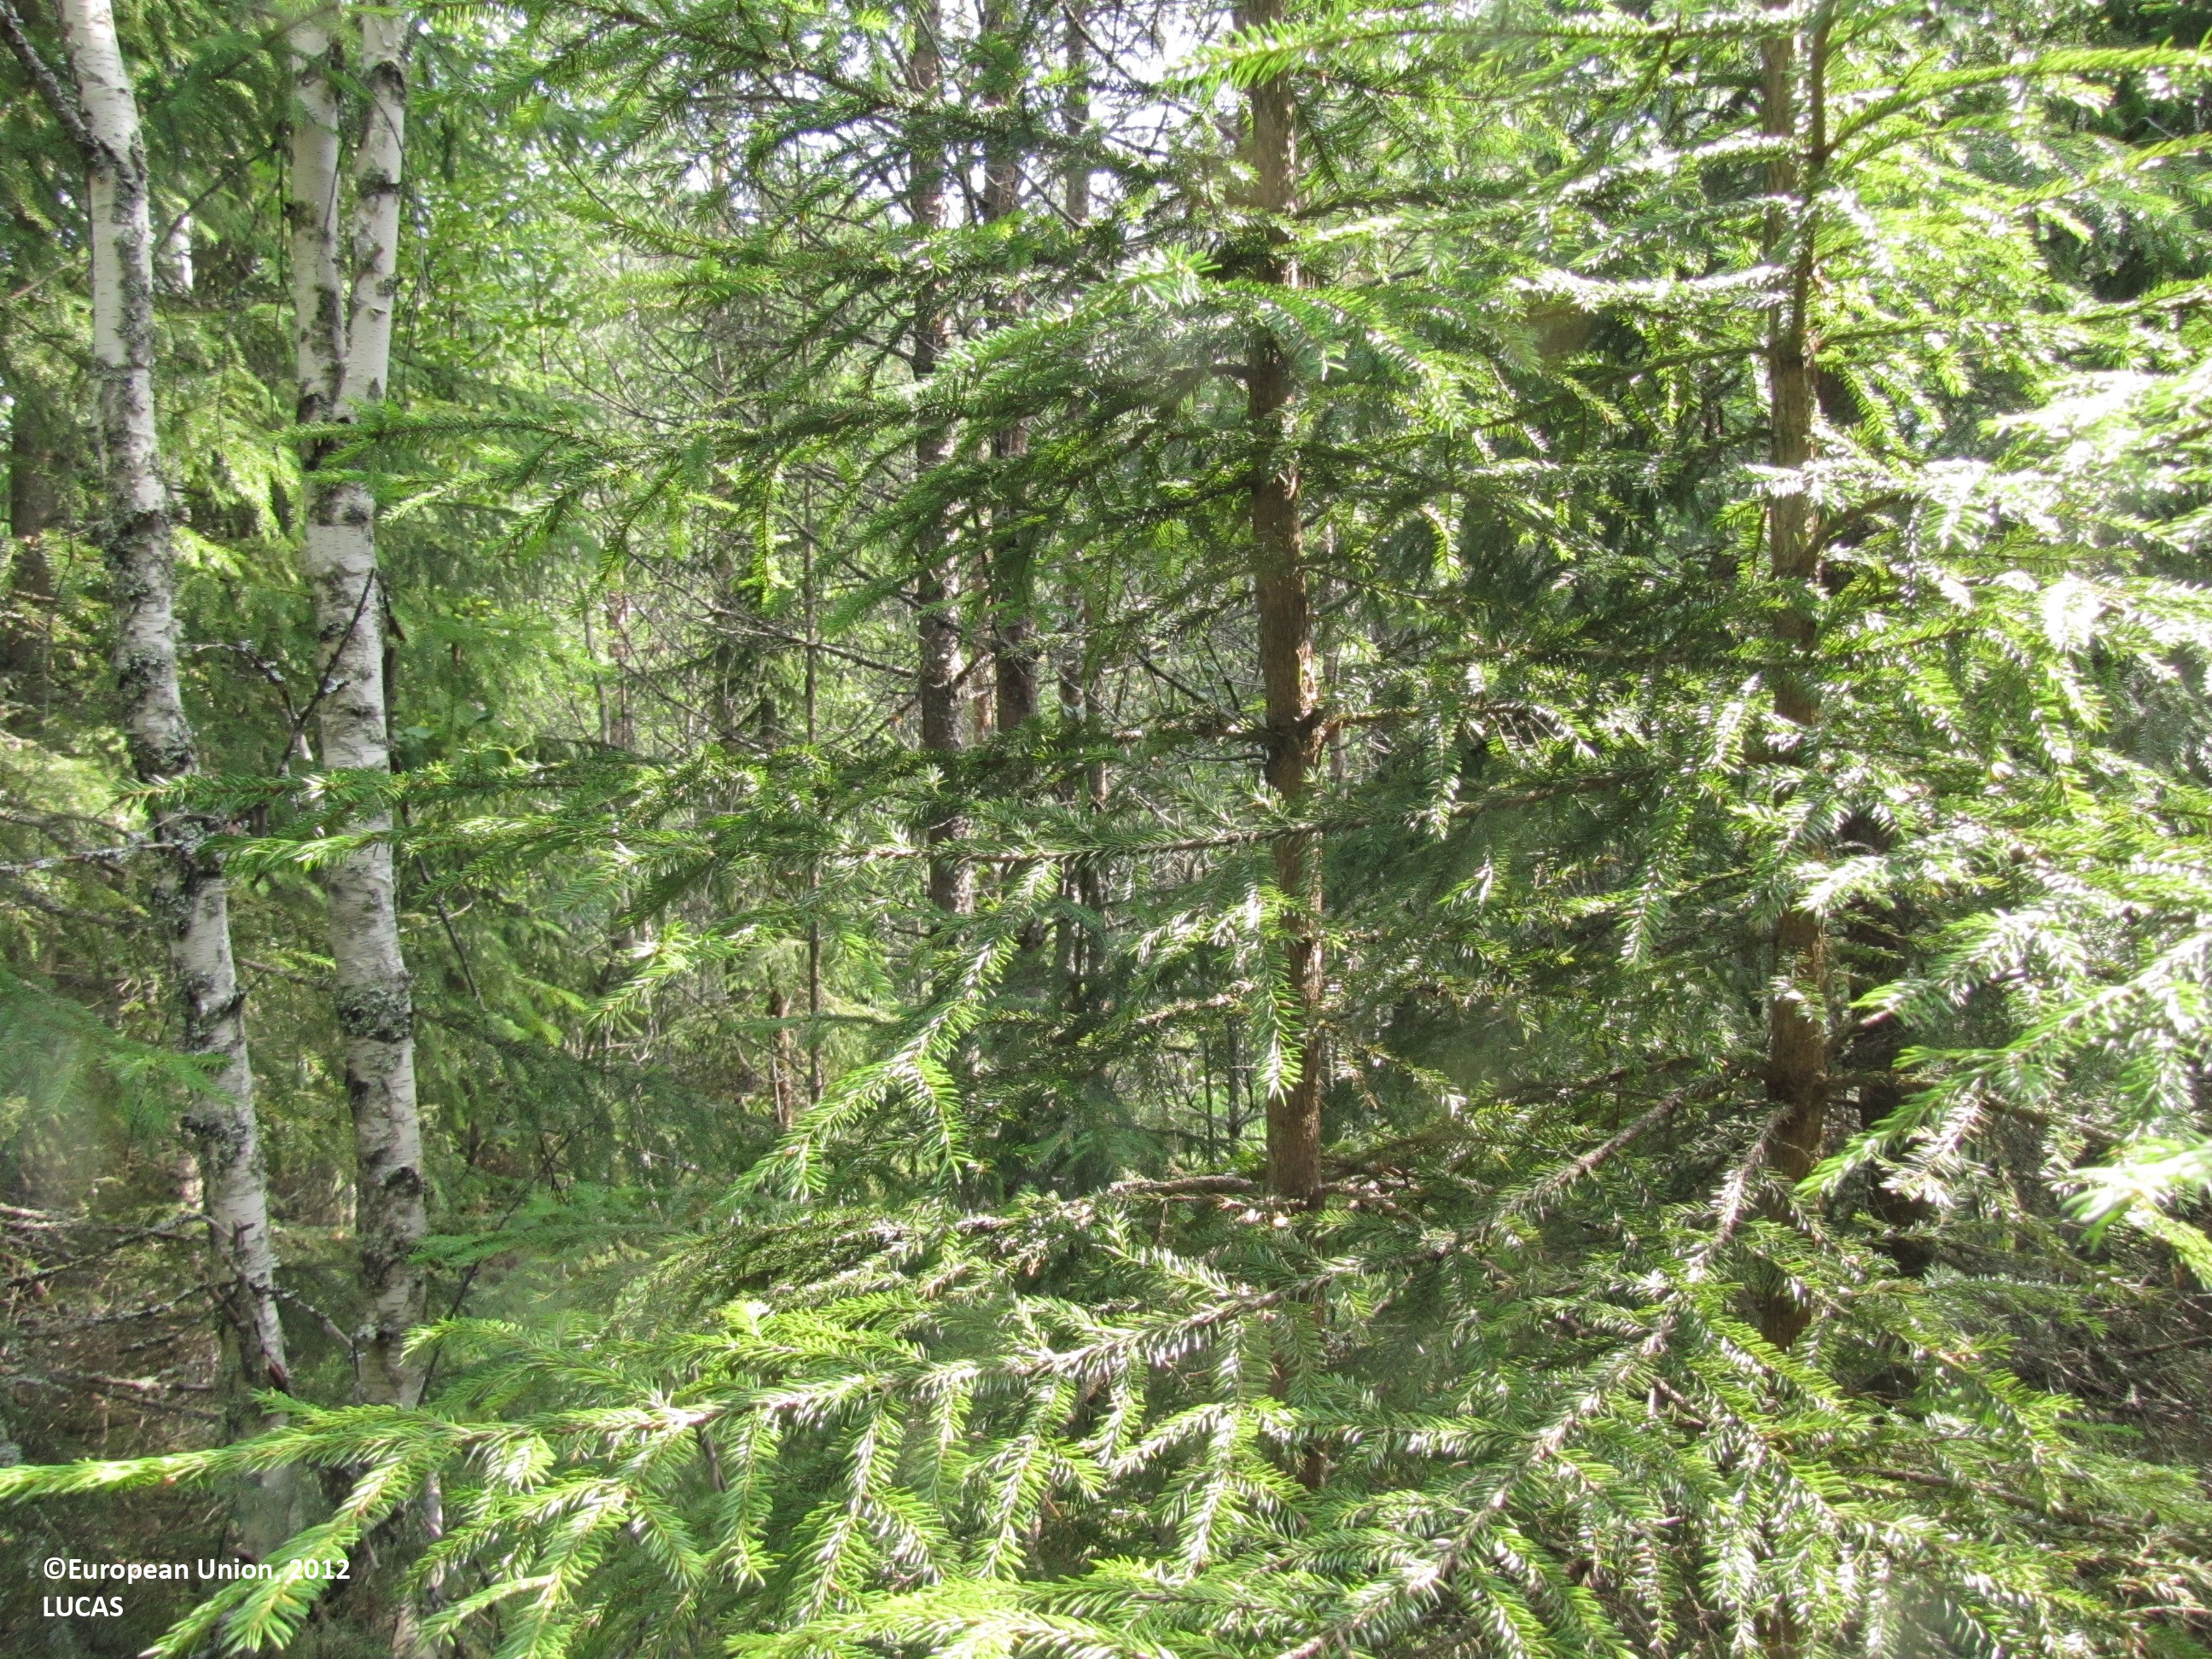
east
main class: Woodland
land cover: Spruce dominated mixed woodland
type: boreal forest
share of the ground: > 75 %
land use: Forestry
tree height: > 5 m
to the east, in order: Spruce dominated mixed woodland; Spruce dominated coniferous woodland
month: July
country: FI
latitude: 61.9650
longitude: 23.2889
